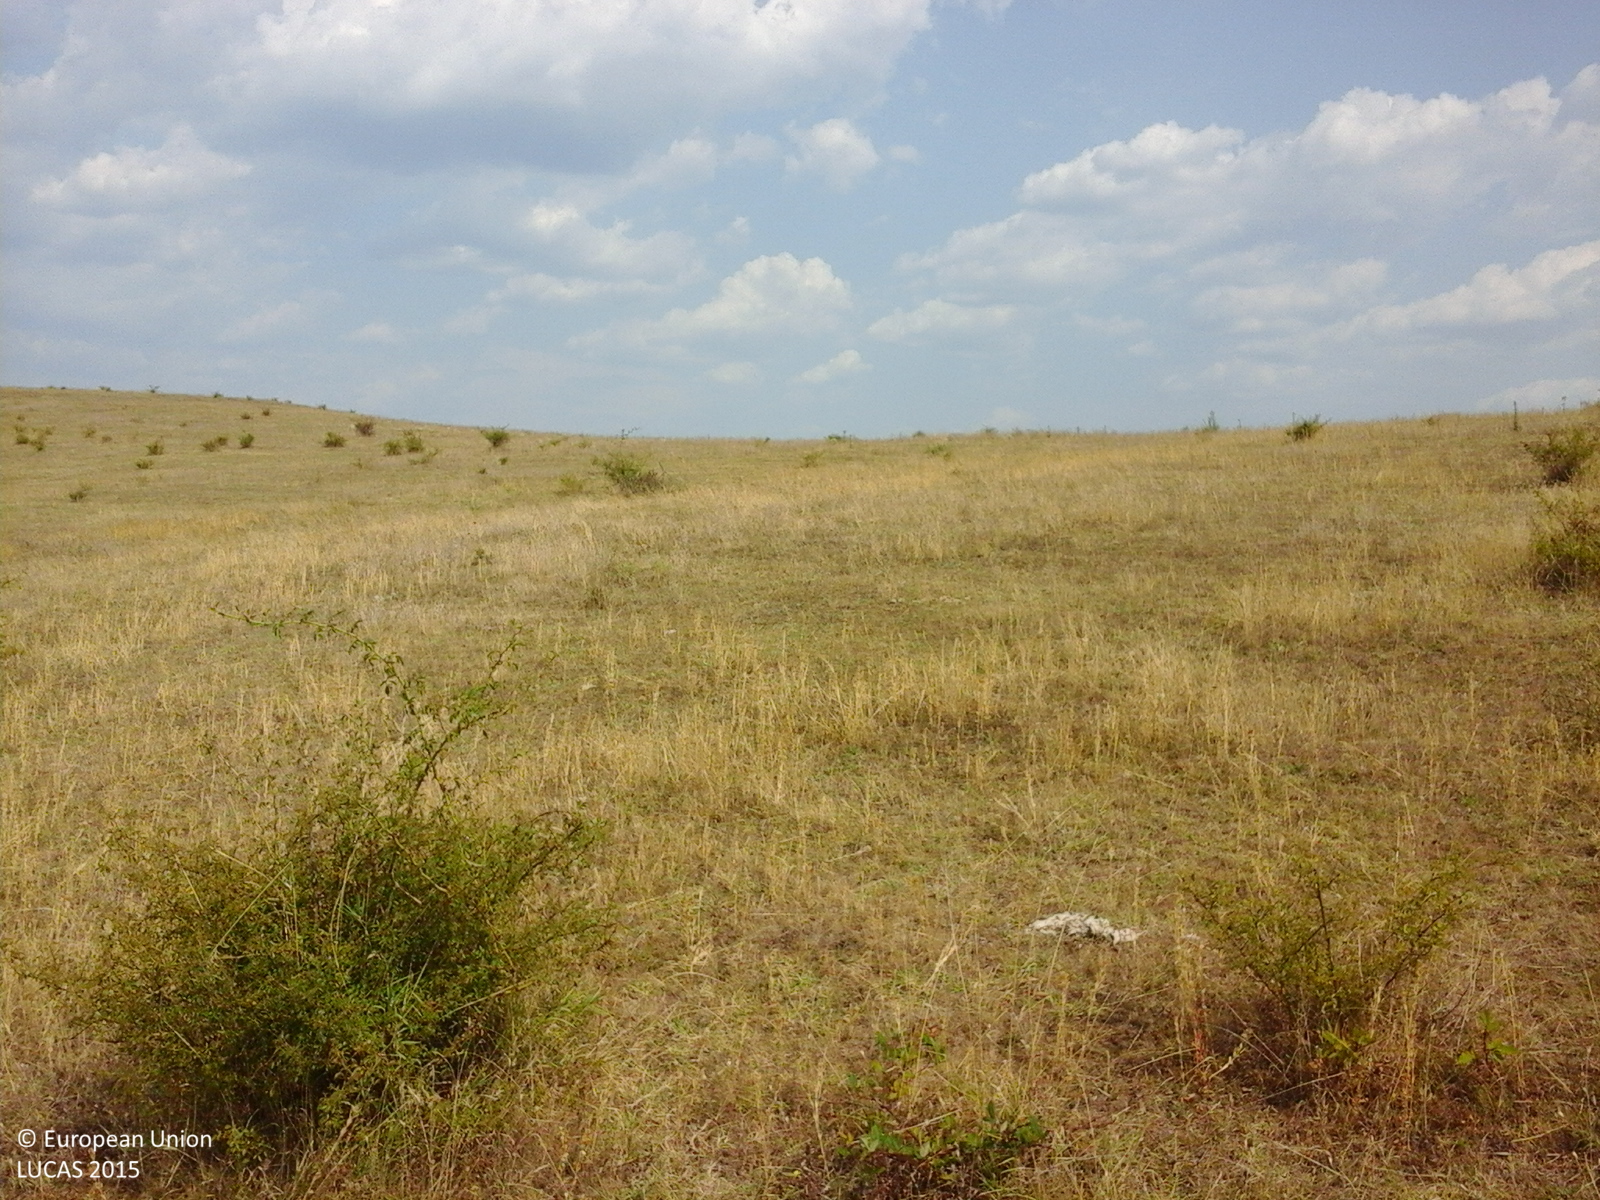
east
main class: Grassland
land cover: Grassland with sparse tree/shrub cover
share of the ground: > 75 %
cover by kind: herbaceous plants 85 %, shrubs 10 %, broadleaved forest trees 5 %
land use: Agriculture (excluding fallow land and kitchen gardens)
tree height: < 5 m
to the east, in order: Grassland with sparse tree/shrub cover
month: August
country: RO
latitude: 44.6223
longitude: 23.5790
